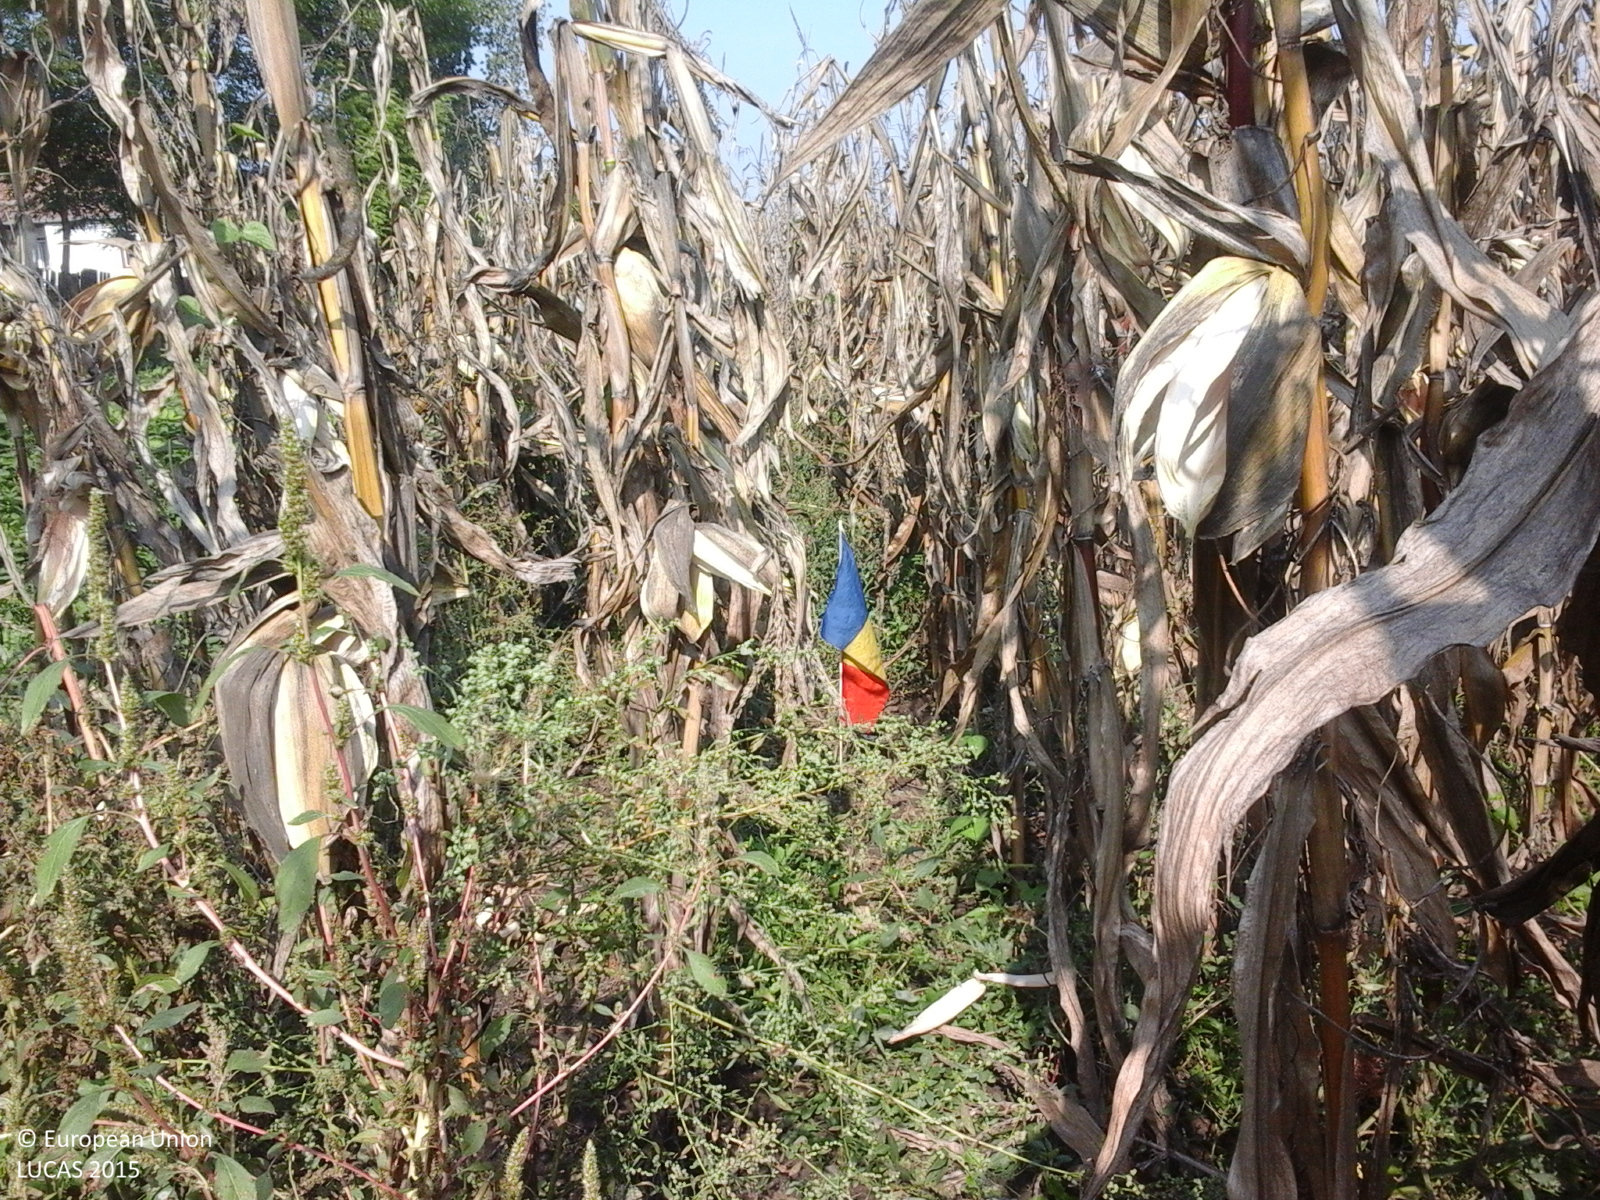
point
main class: Cropland
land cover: Maize
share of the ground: > 75 %
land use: Agriculture (excluding fallow land and kitchen gardens)
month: October
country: RO
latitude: 46.5588
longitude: 24.1285
